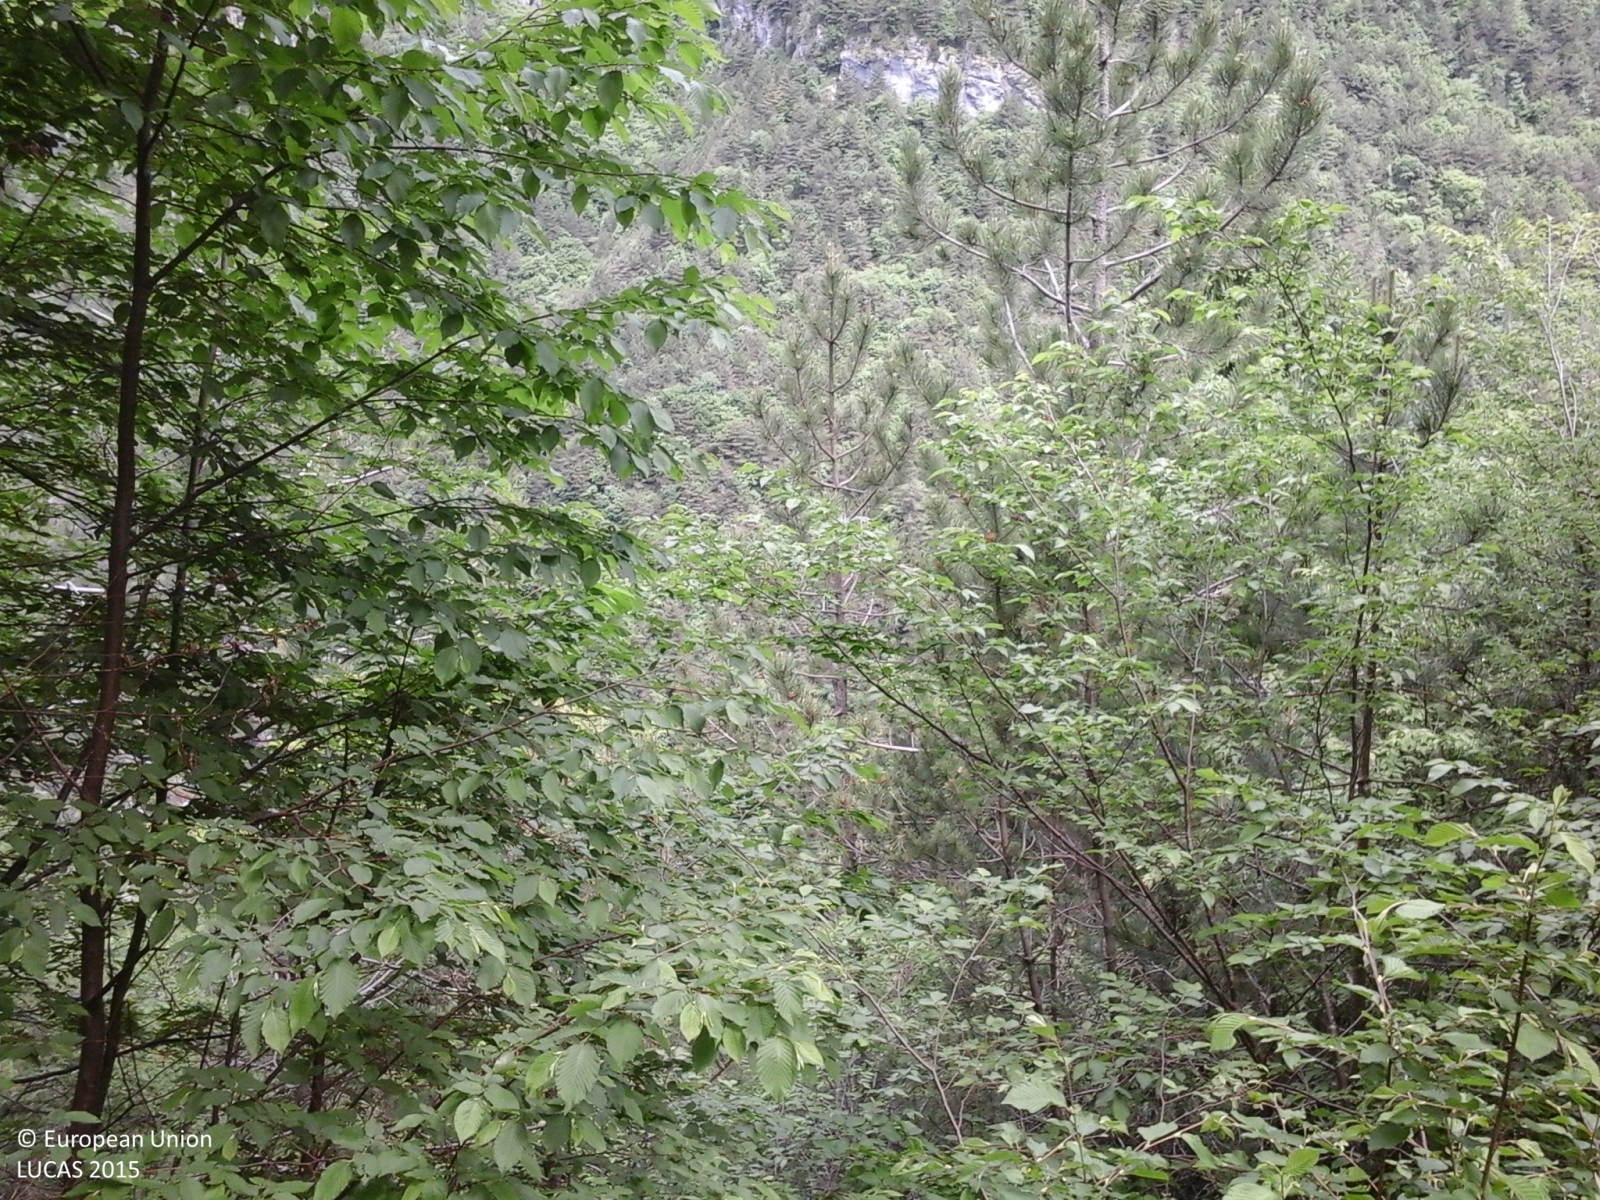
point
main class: Woodland
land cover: Other mixed woodland
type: mesophytic deciduous forest
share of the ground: > 75 %
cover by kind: broadleaved forest trees 60 %, coniferous forest trees 30 %, shrubs 10 %
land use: Semi-natural and natural areas not in use
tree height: > 5 m
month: June
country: IT
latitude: 46.2180
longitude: 12.3176
